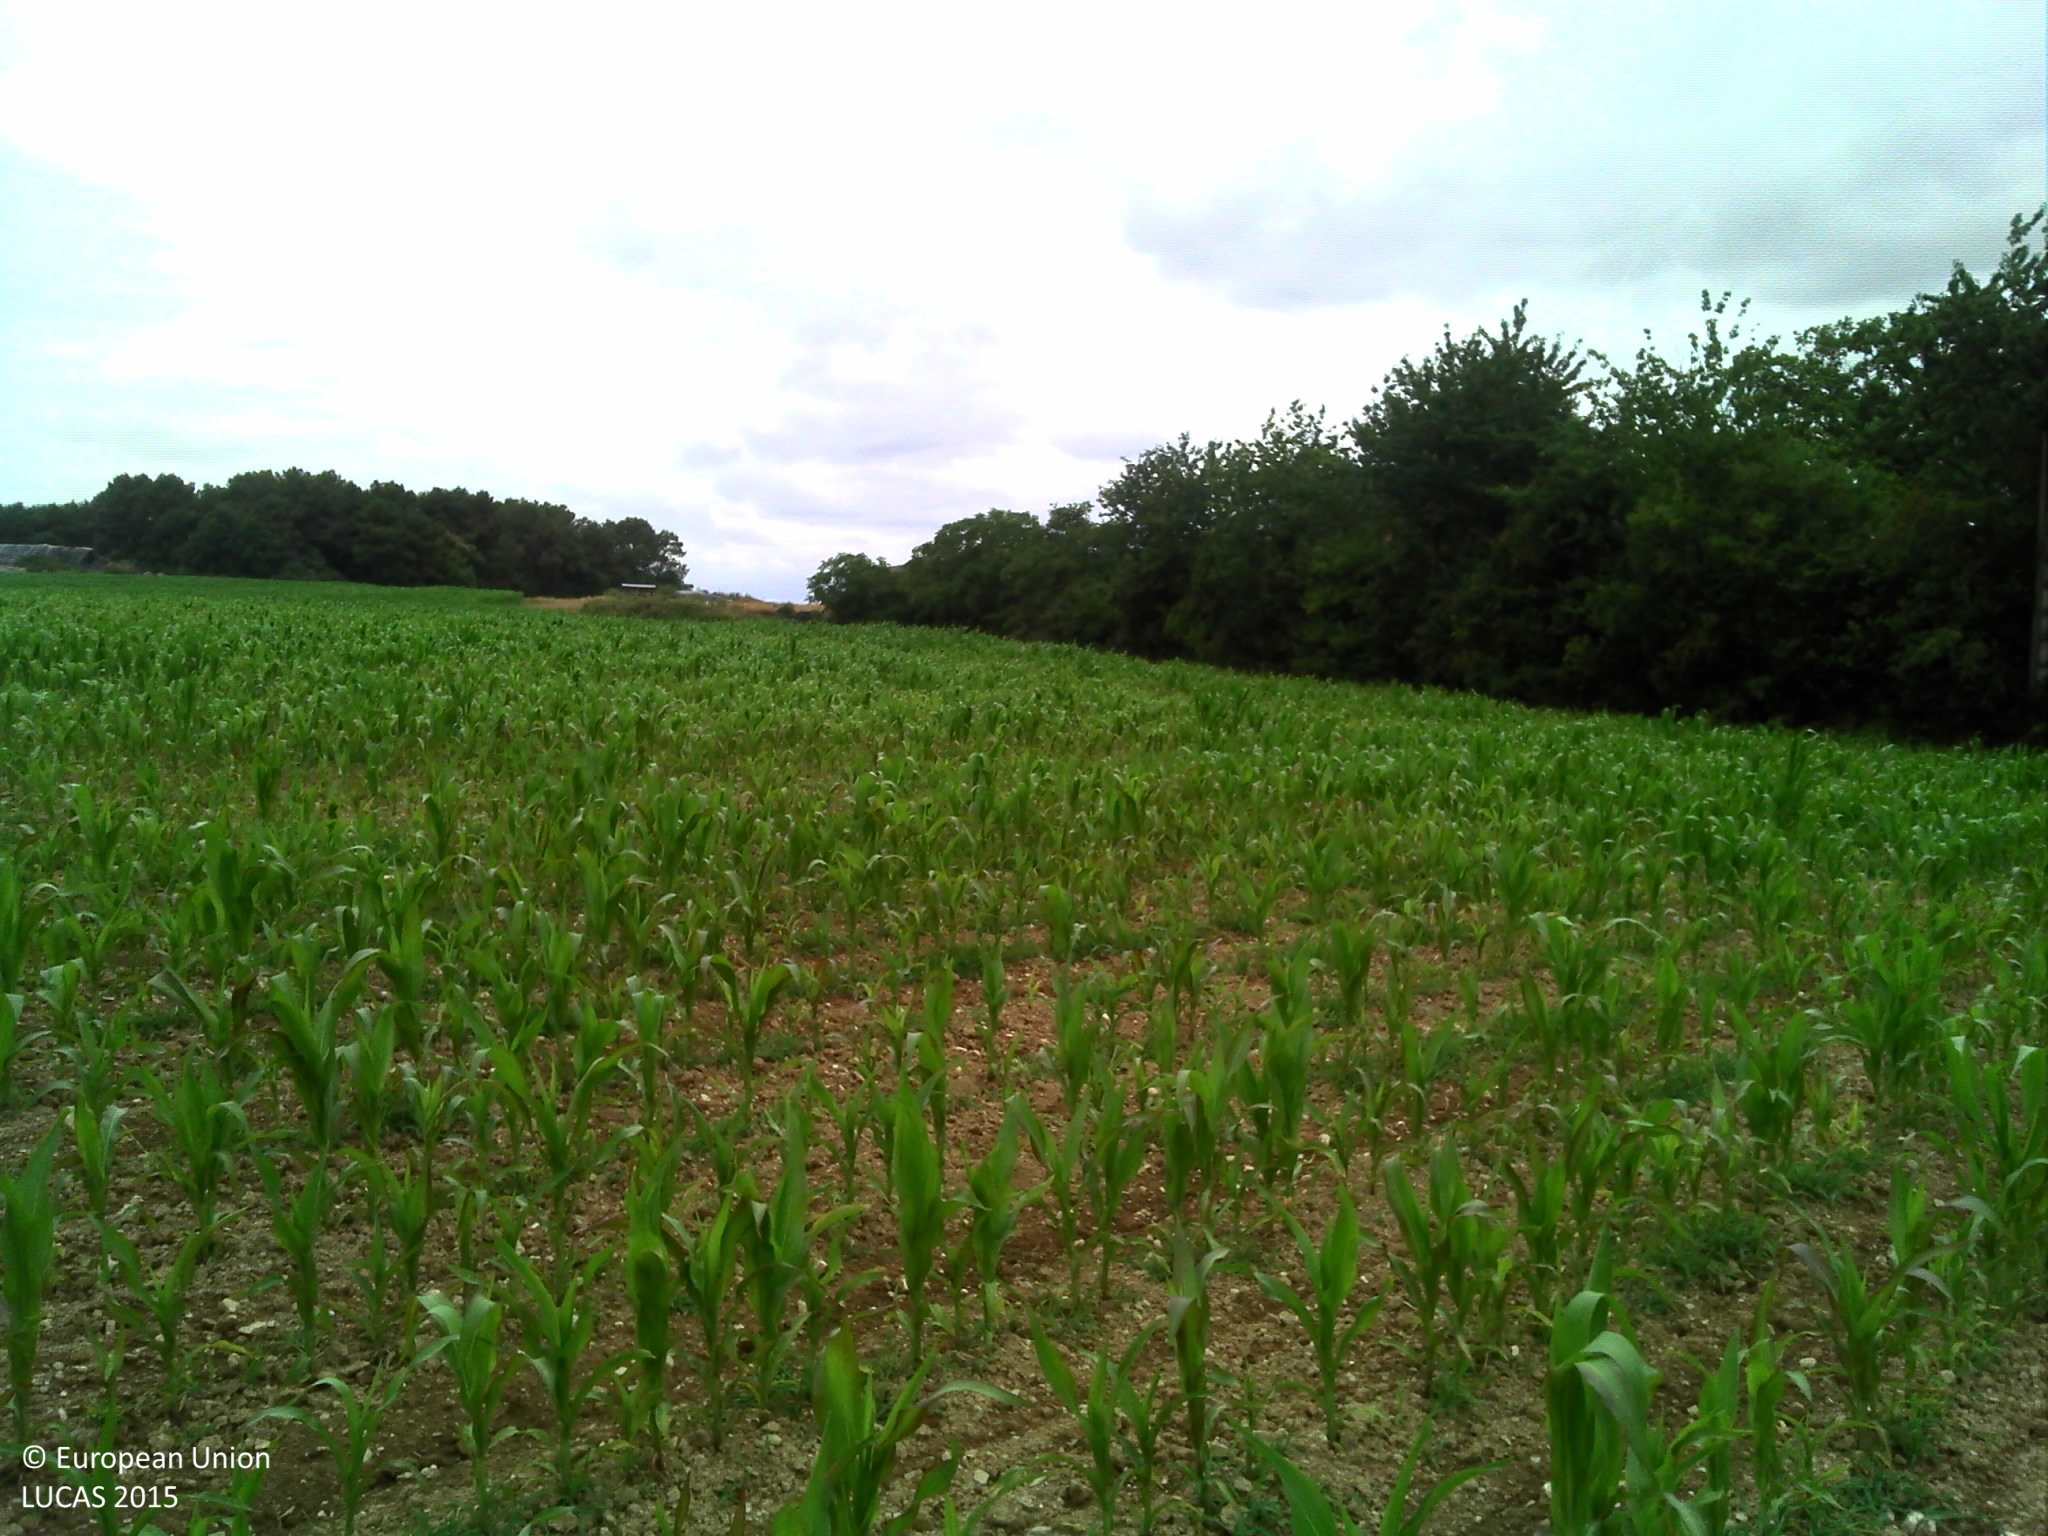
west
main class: Cropland
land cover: Maize
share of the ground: 10 - 25 %
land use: Agriculture (excluding fallow land and kitchen gardens)
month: July
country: FR
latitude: 47.8372
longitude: -2.0092
